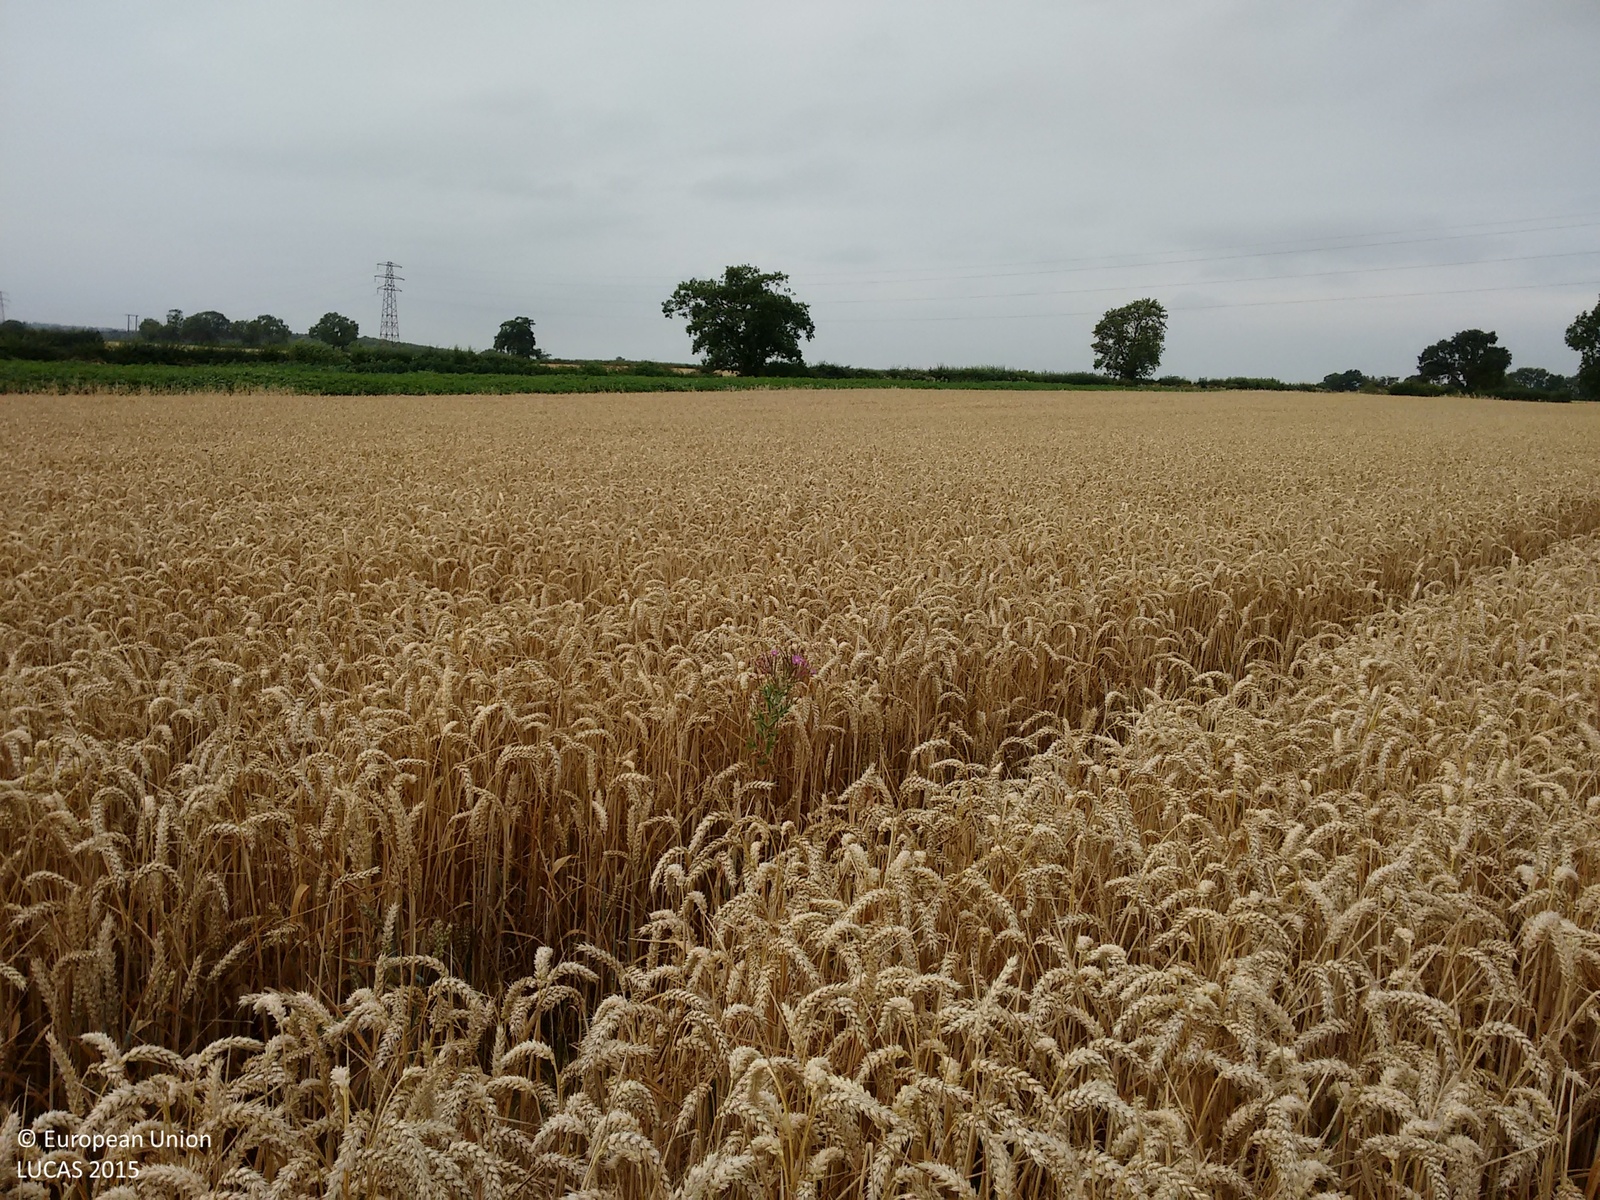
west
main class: Cropland
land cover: Common wheat
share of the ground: > 75 %
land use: Agriculture (excluding fallow land and kitchen gardens)
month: August
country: GB
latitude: 52.2987
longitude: -0.8199
